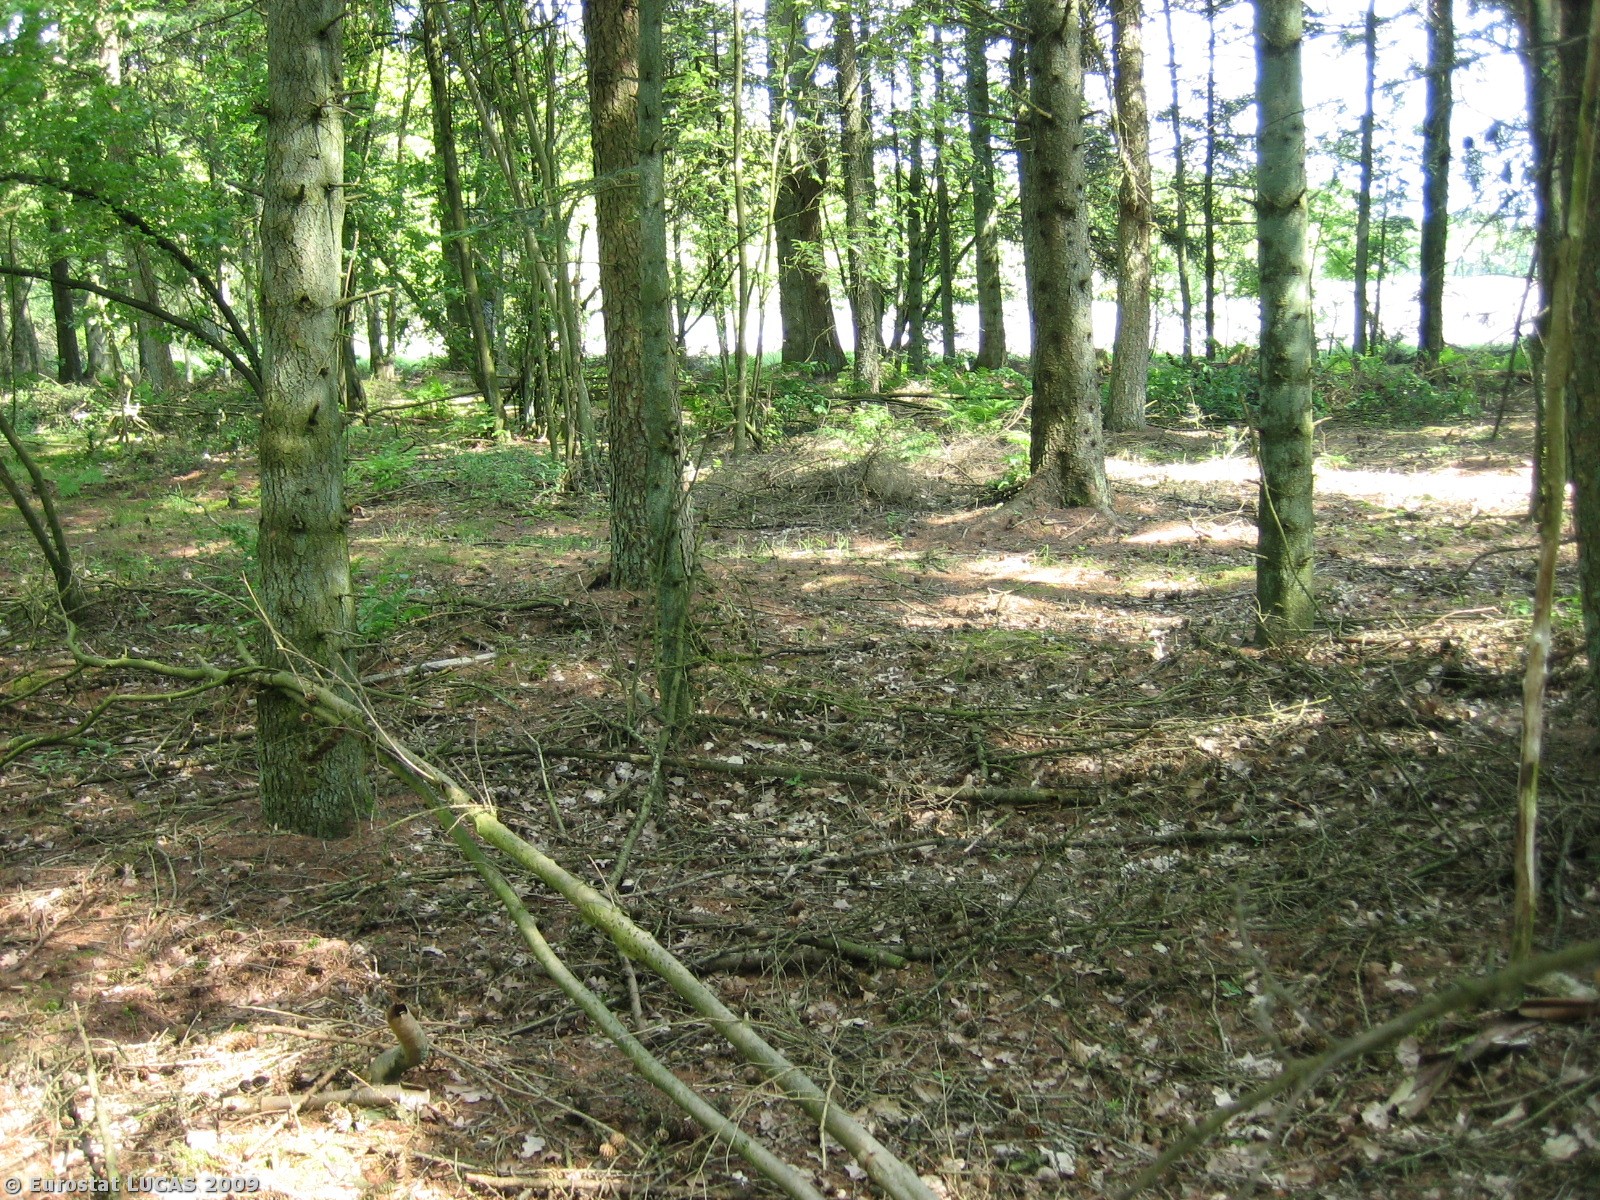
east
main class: Woodland
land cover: Mixed woodland
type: mesophytic deciduous forest
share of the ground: > 75 %
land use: Forestry
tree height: > 5 m
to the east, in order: Mixed woodland; Grass margins; Potatoes; Grass margins; Broadleaved woodland; Grassland without tree/shrub cover; Barley
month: May
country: DK
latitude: 56.0954
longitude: 9.2133
